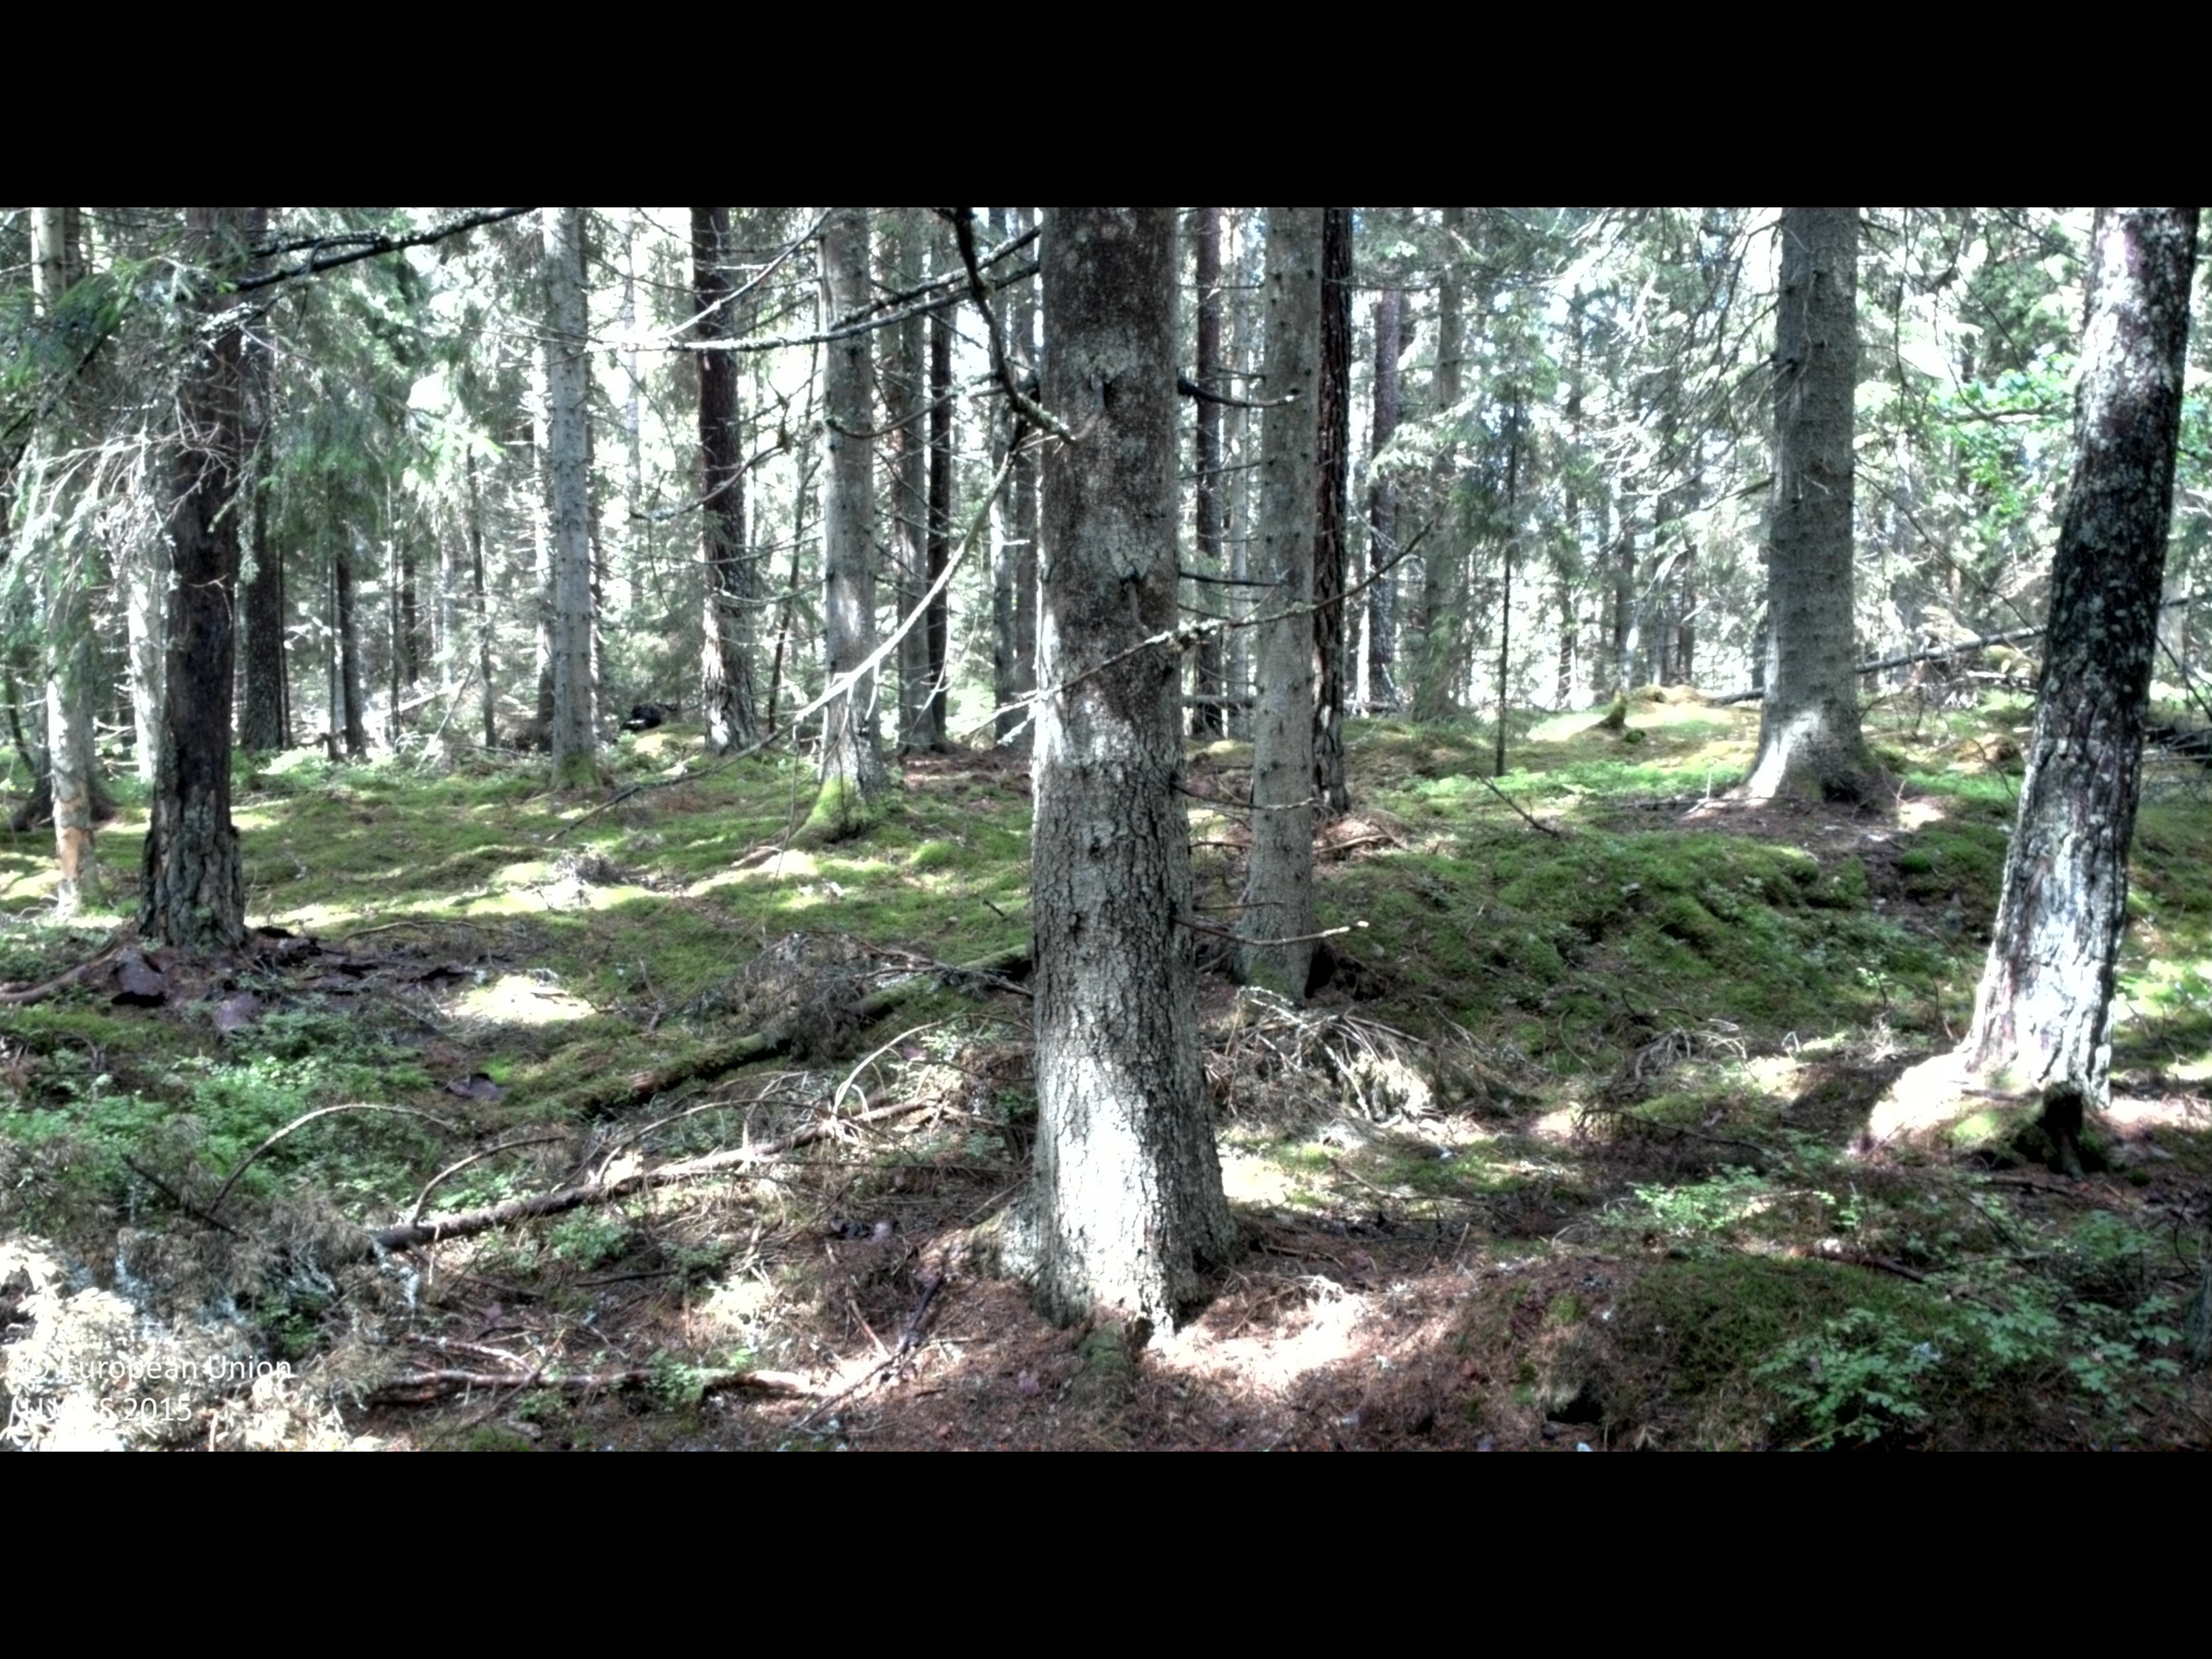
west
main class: Woodland
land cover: Spruce dominated coniferous woodland
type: boreal forest
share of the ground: > 75 %
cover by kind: coniferous forest trees 80 %, shrubs 10 %, lichens and mosses 10 %
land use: Forestry
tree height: > 5 m
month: June
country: SE
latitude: 58.0623
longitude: 16.1150
